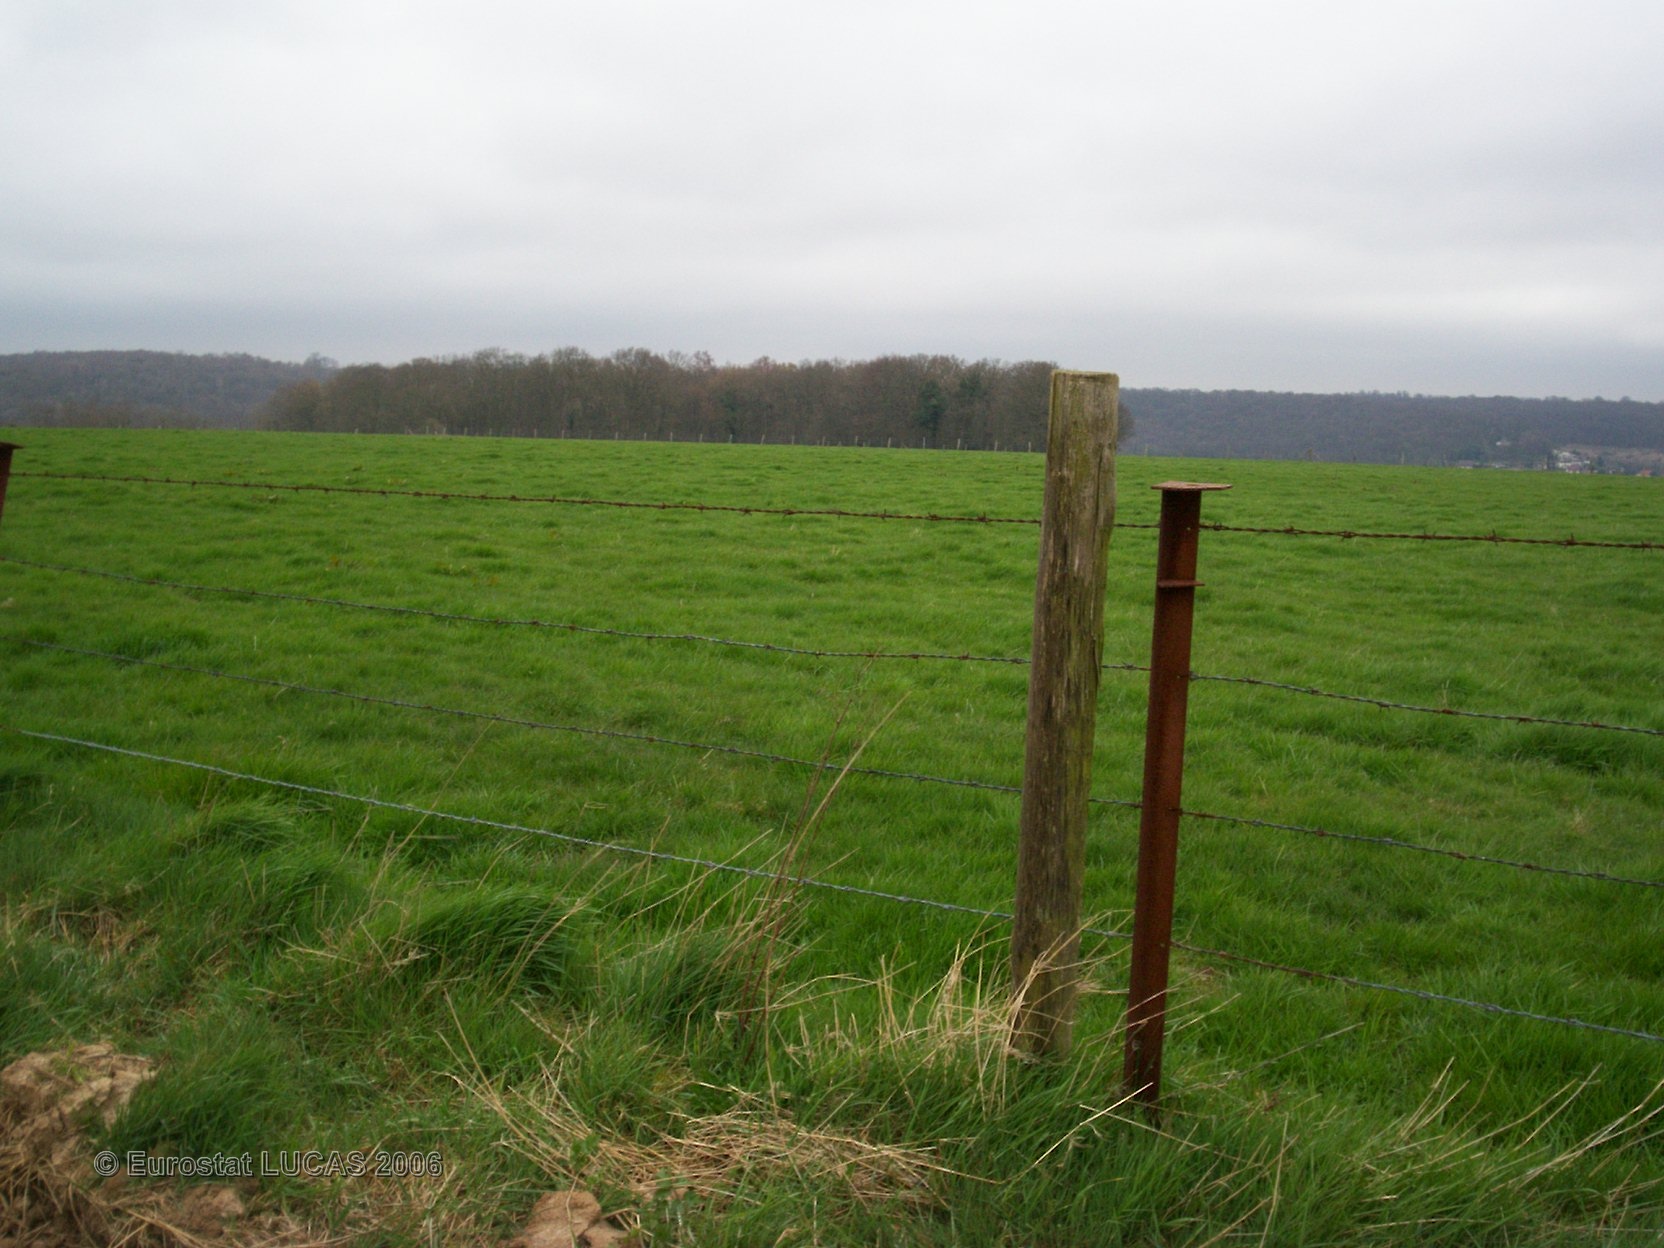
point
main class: Grassland
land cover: Grassland without tree/shrub cover
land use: Agriculture (excluding fallow land and kitchen gardens)
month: April
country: FR
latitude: 49.5145
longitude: 0.9302
